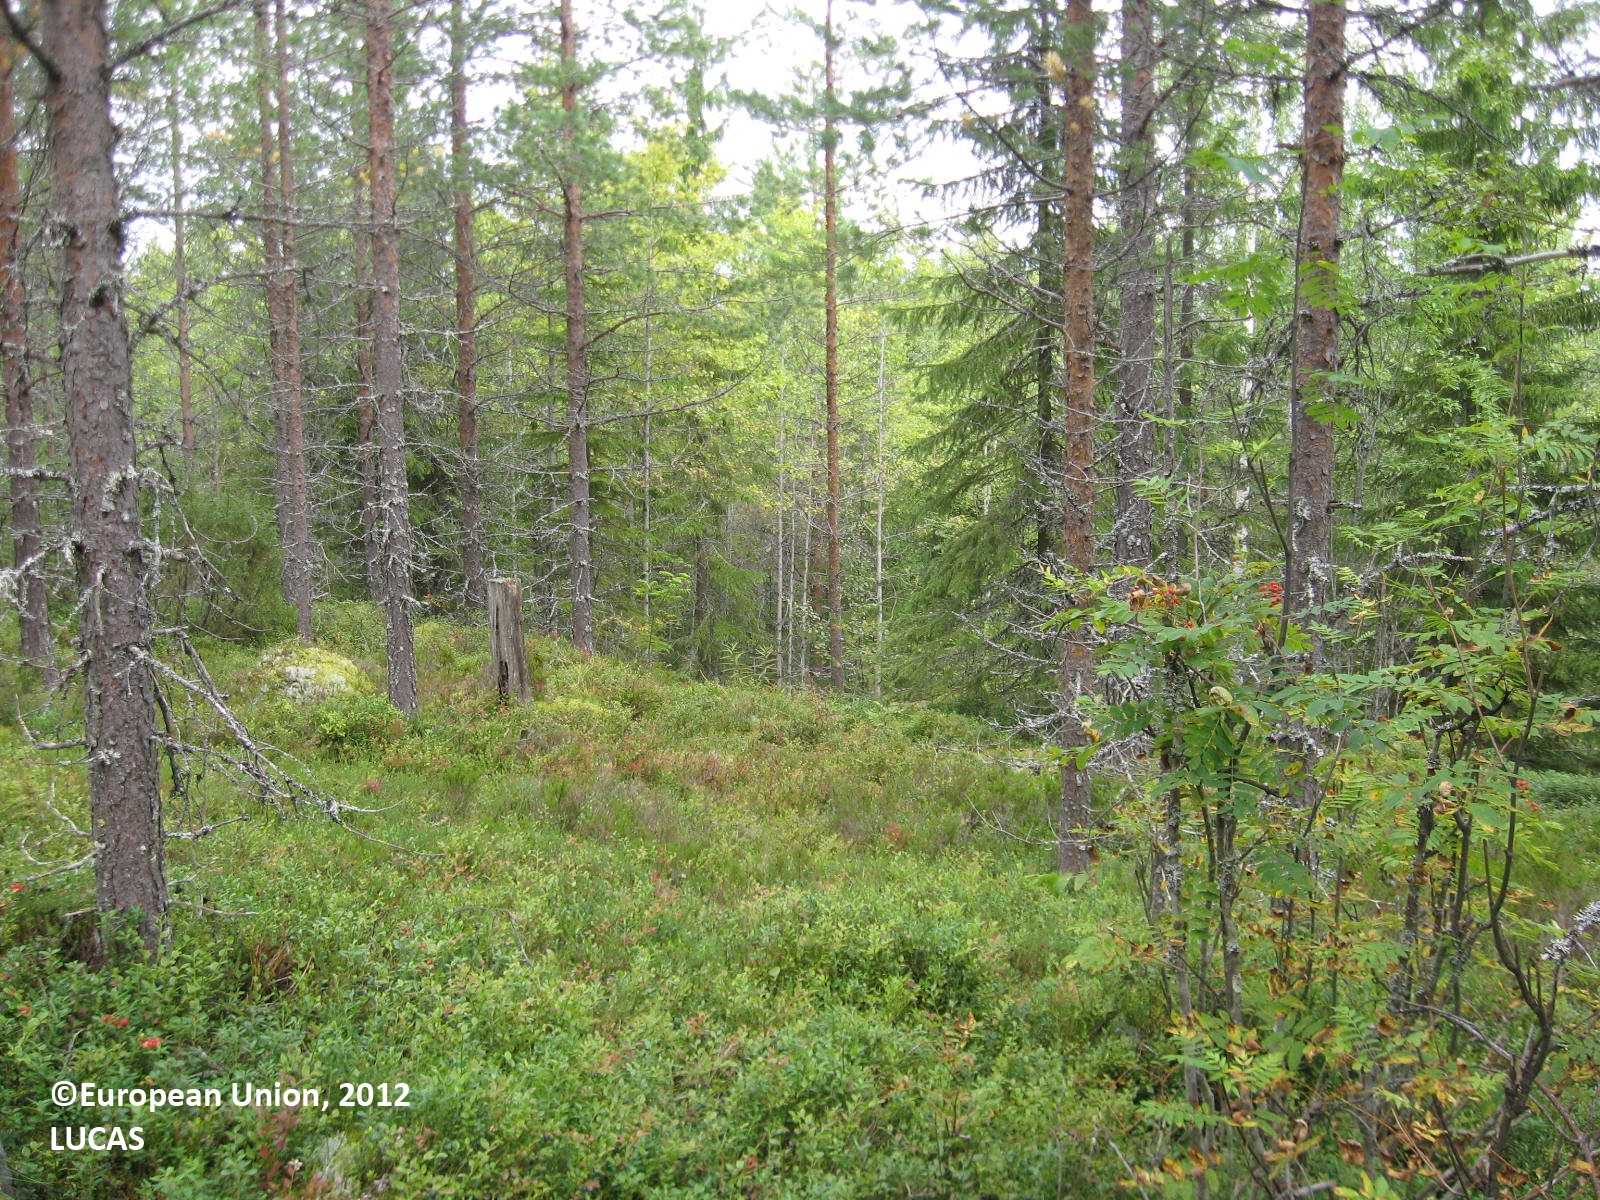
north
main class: Woodland
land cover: Pine dominated mixed woodland
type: boreal forest
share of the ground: > 75 %
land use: Forestry
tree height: > 5 m
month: August
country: FI
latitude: 63.5514
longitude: 29.8623
